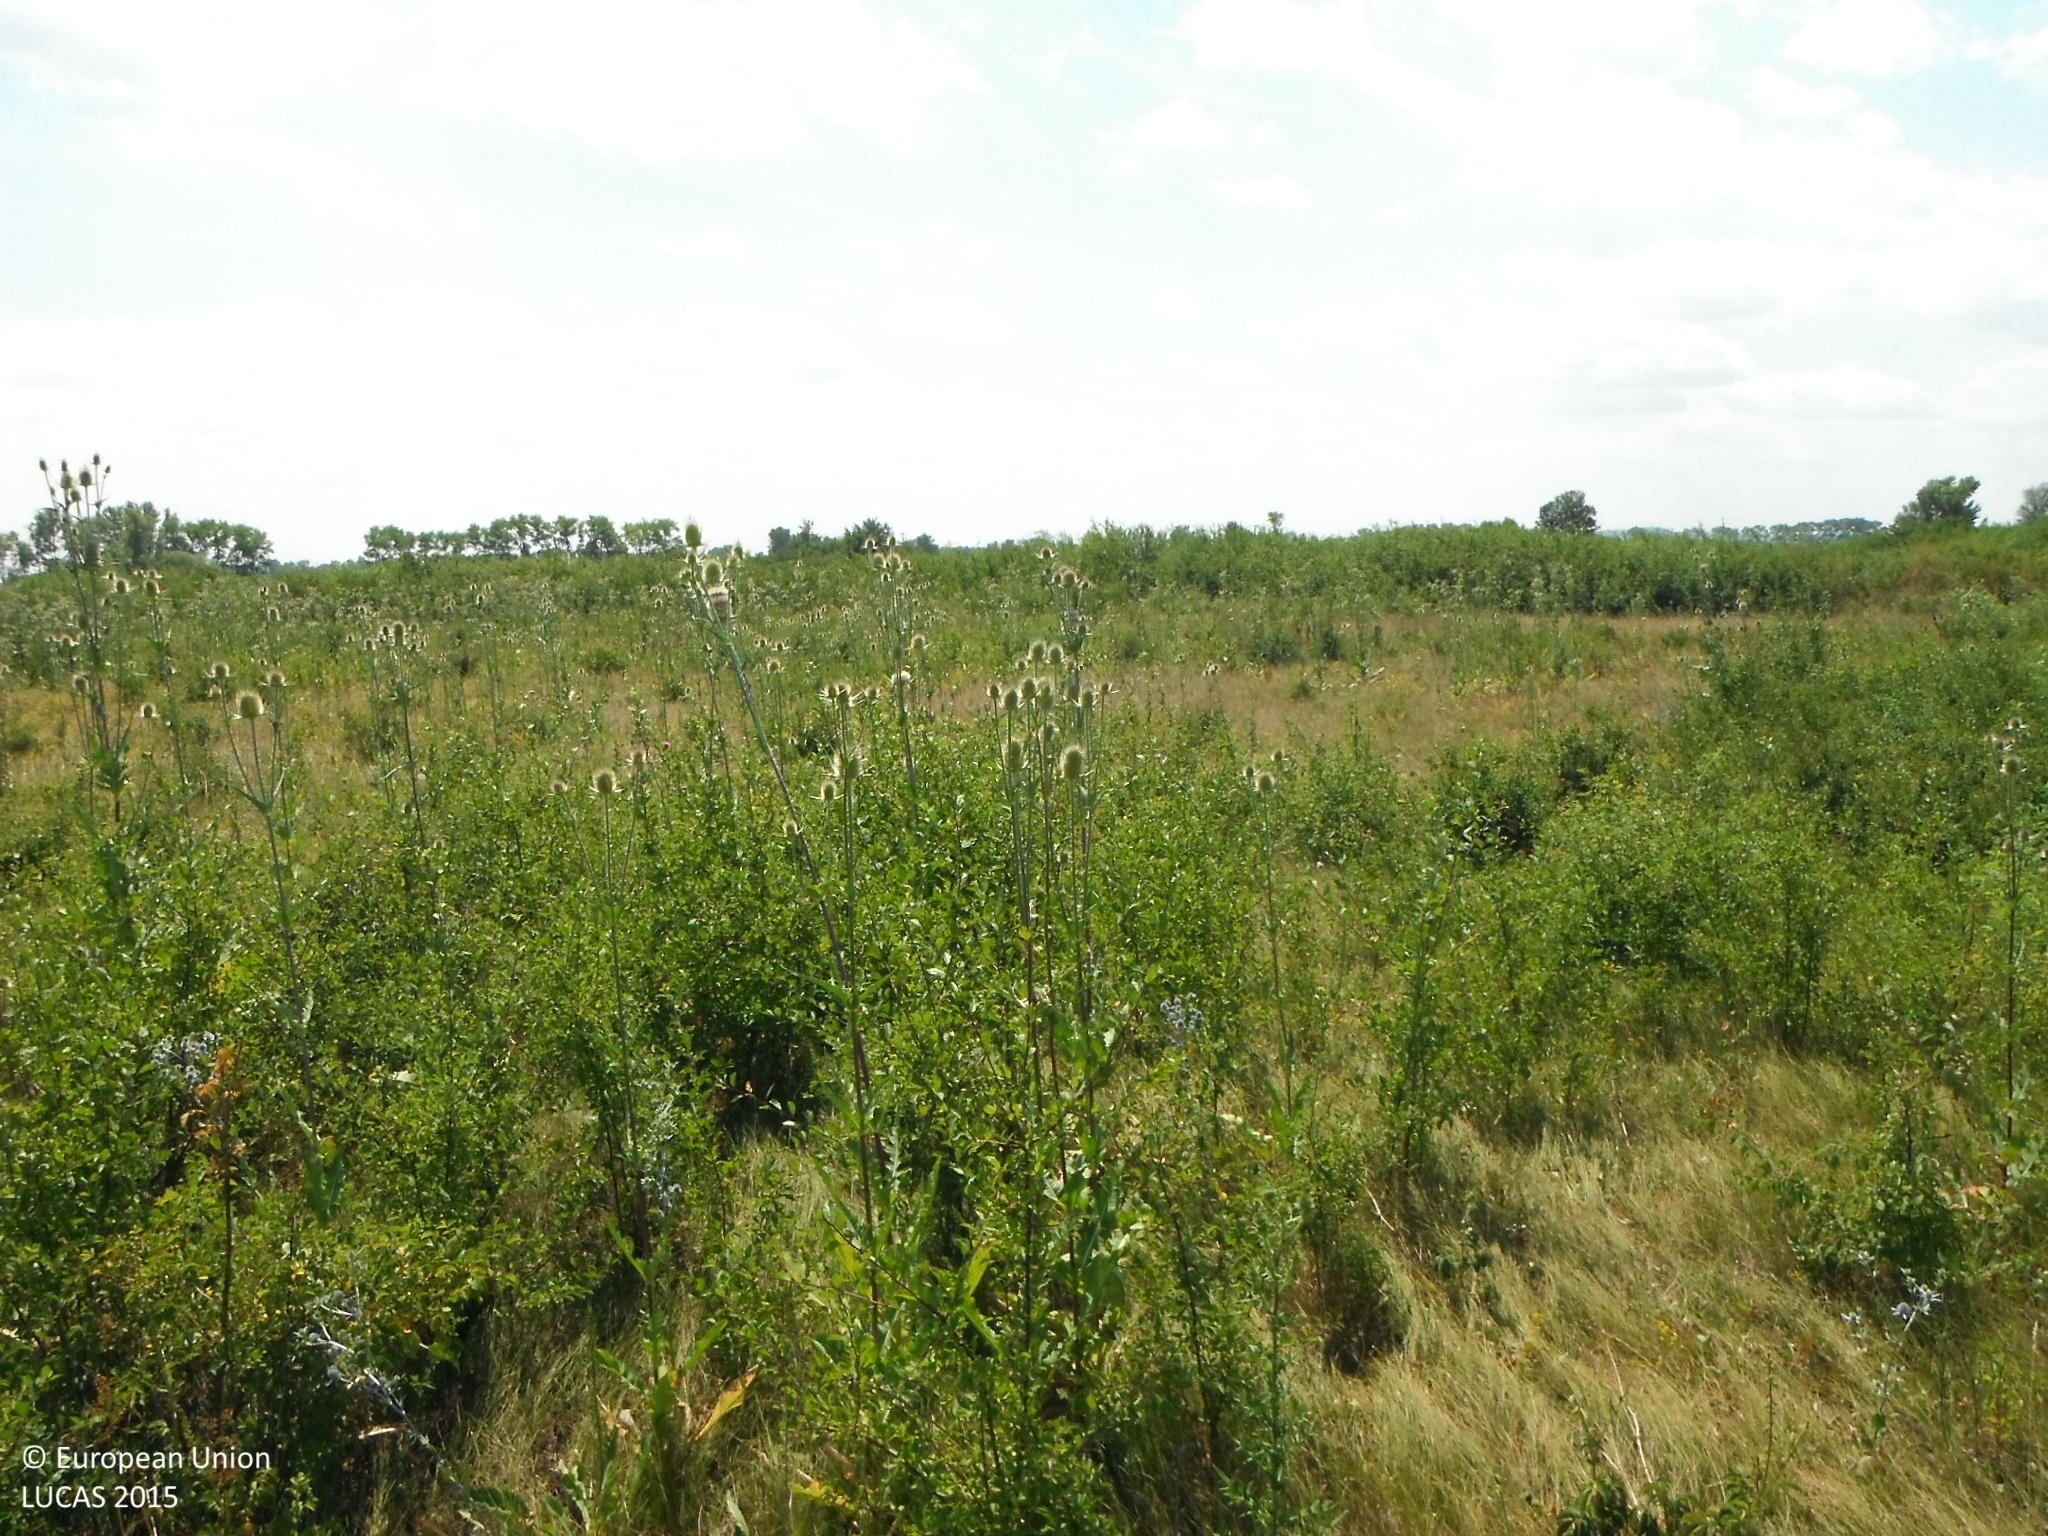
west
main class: Grassland
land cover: Spontaneously vegetated surfaces
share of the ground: > 75 %
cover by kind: herbaceous plants 100 %
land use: Agriculture (excluding fallow land and kitchen gardens)
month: July
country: SK
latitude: 48.5781
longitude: 21.8858
